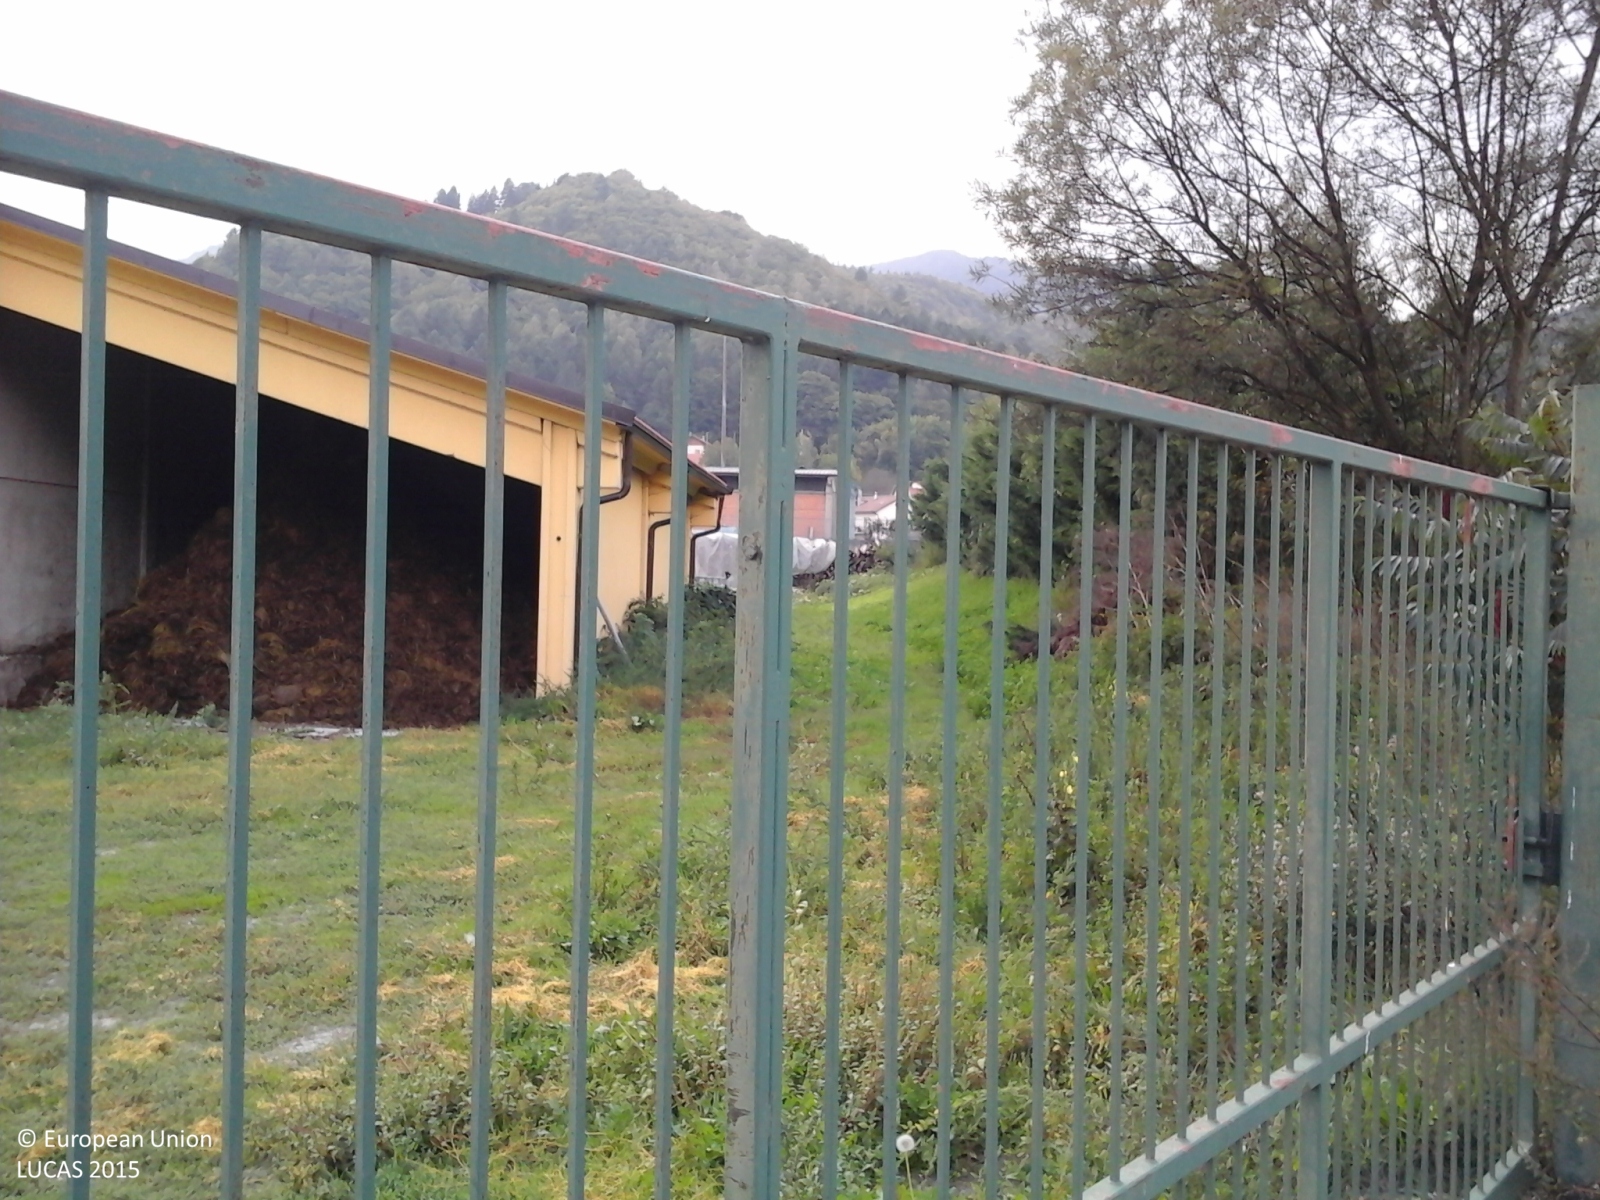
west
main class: Grassland
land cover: Spontaneously vegetated surfaces
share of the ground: > 75 %
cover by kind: herbaceous plants 100 %
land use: Agriculture (excluding fallow land and kitchen gardens)
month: September
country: IT
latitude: 44.2432
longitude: 8.1134
